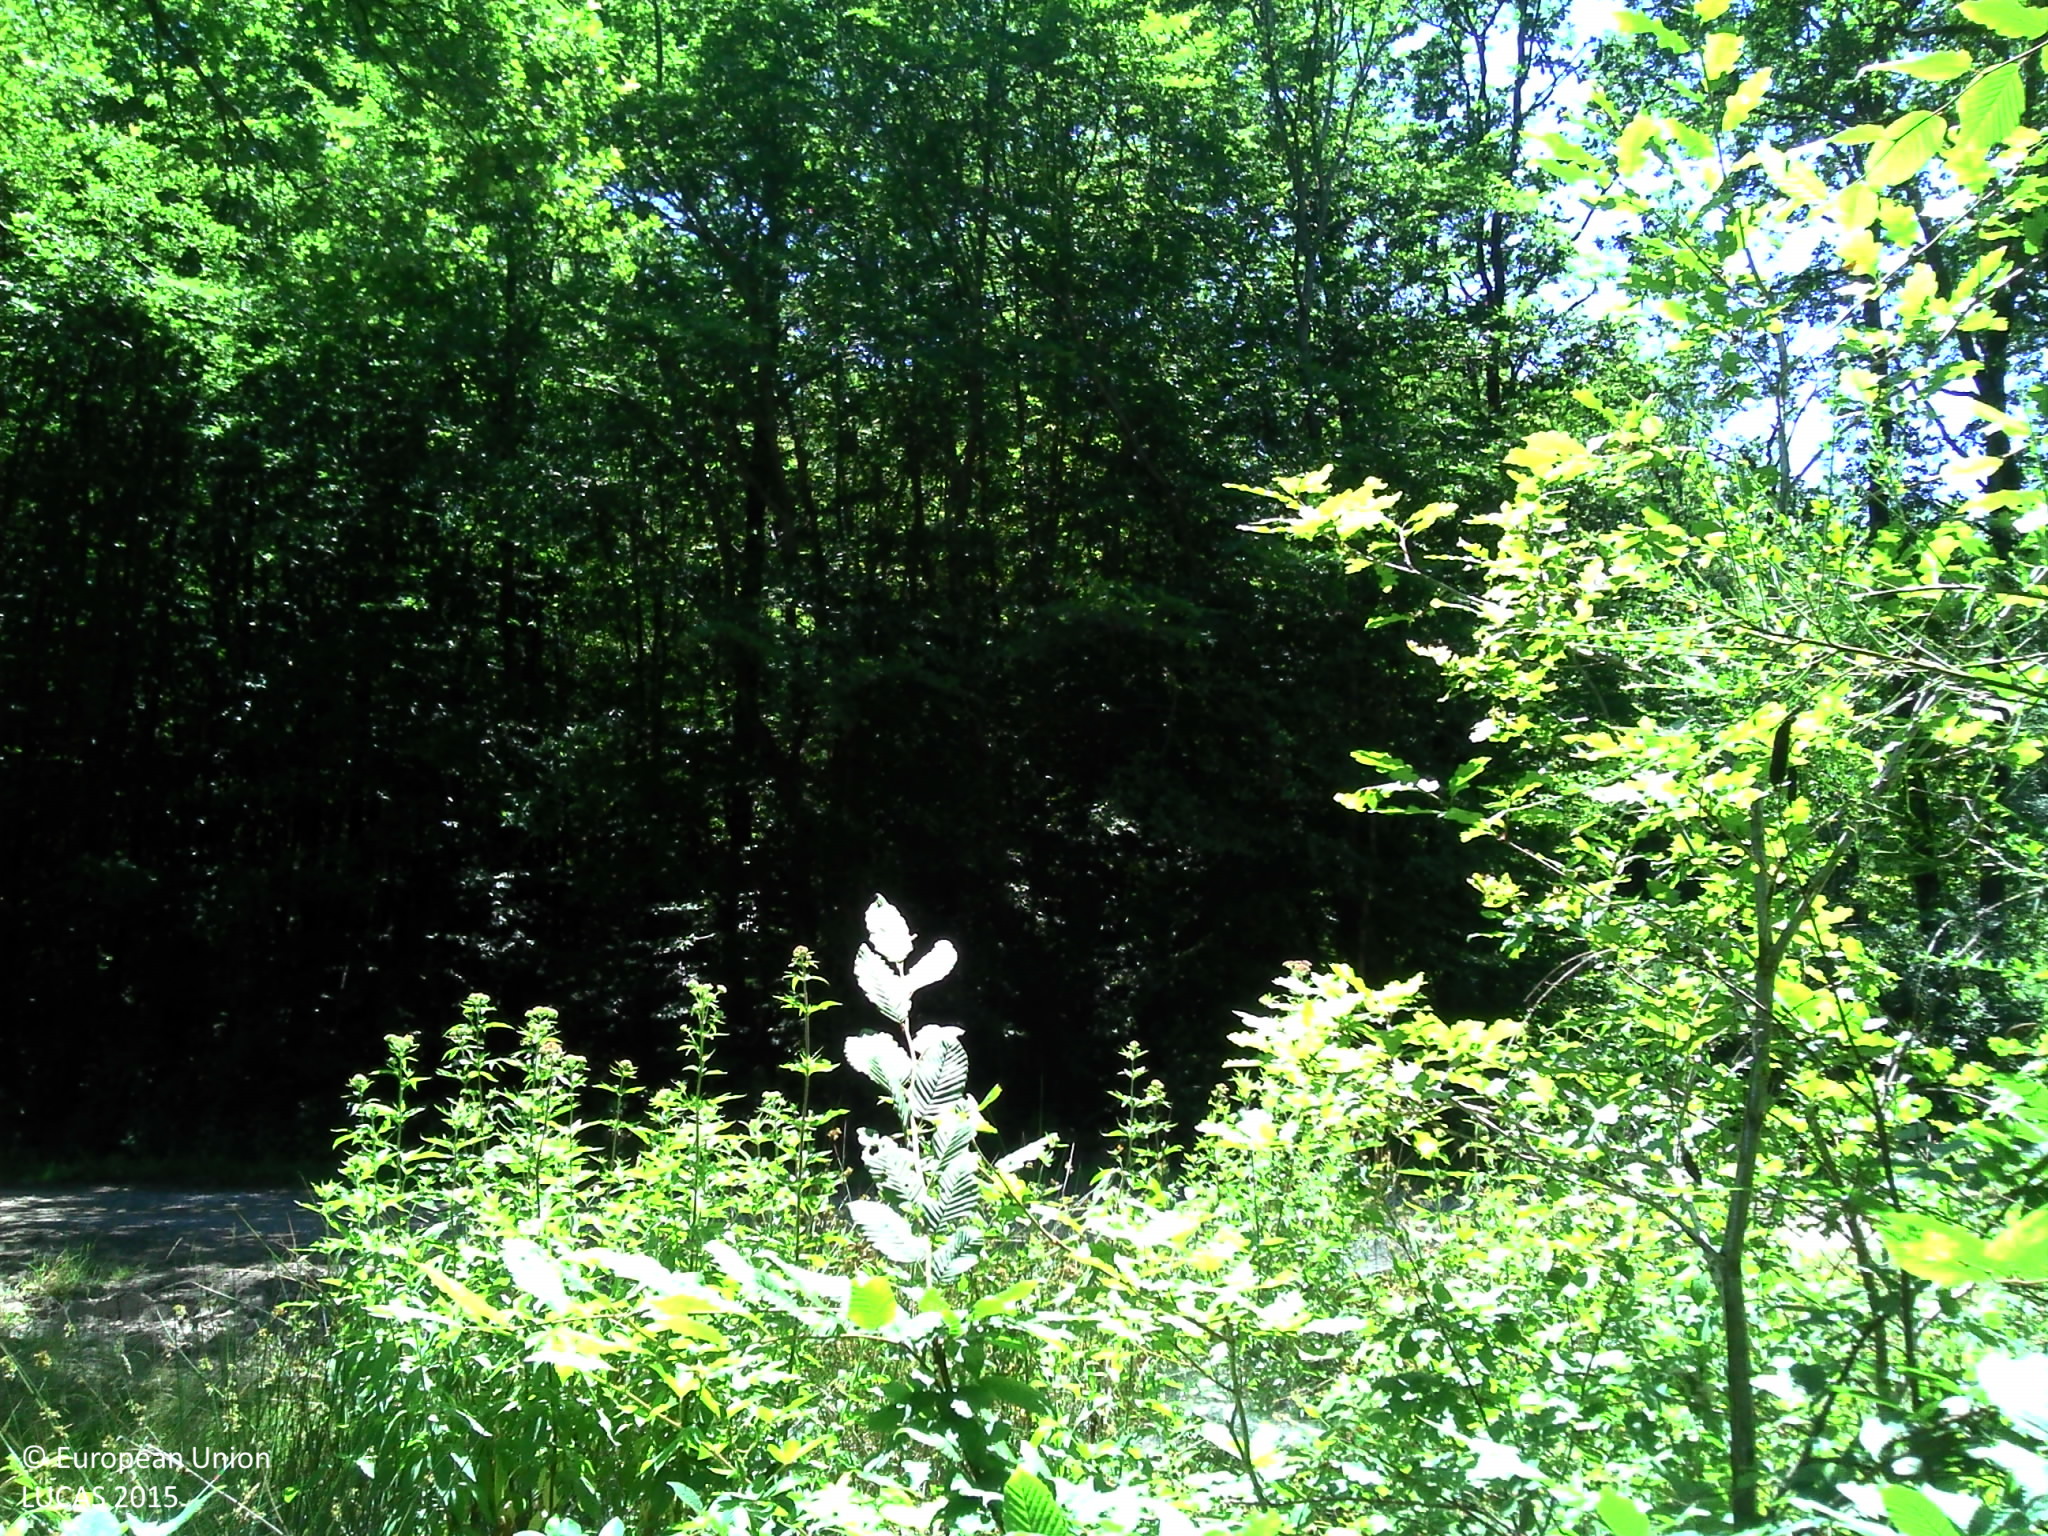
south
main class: Woodland
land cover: Broadleaved woodland
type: mesophytic deciduous forest
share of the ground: > 75 %
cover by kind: broadleaved forest trees 90 %, herbaceous plants 10 %
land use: Forestry
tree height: > 5 m
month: June
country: FR
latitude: 46.1985
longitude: 3.3514
